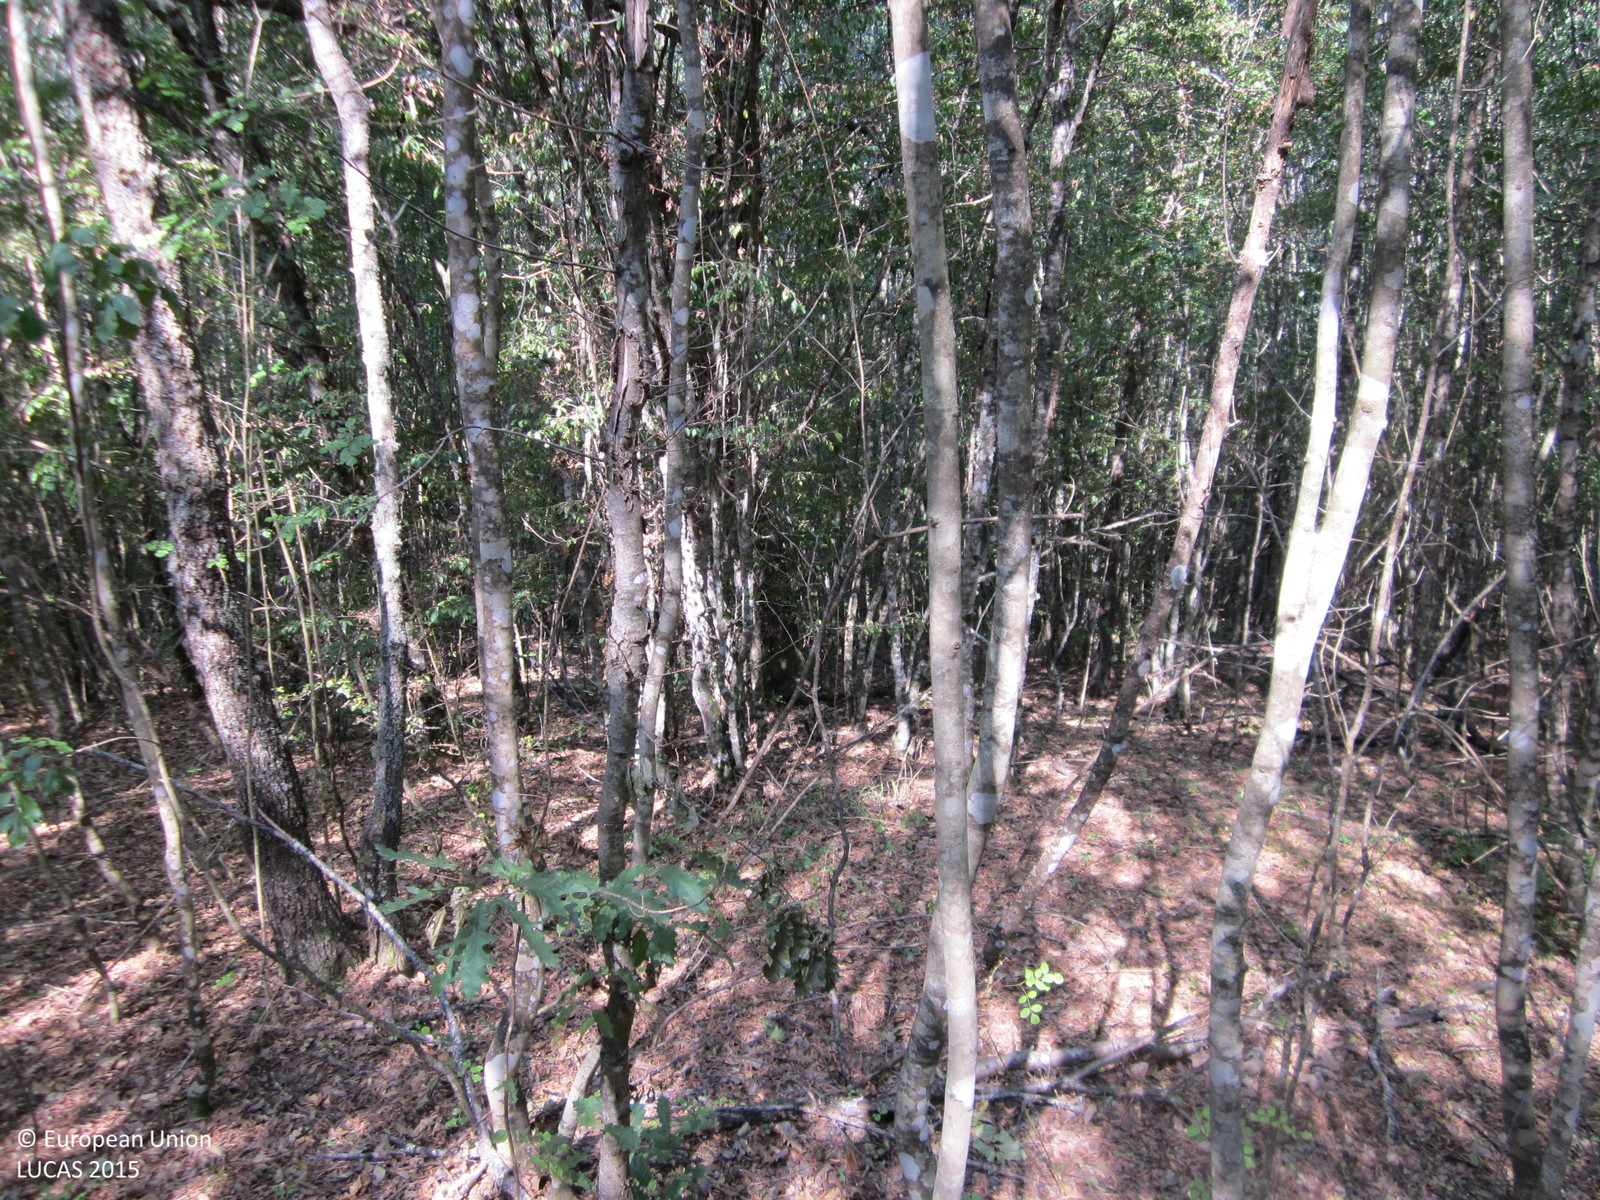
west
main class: Woodland
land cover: Broadleaved woodland
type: thermophilous deciduous forest
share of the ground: > 75 %
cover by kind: broadleaved forest trees 95 %, unconsolidated bare surface 5 %
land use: Forestry
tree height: > 5 m
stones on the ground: < 10 %
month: August
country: BG
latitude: 42.0358
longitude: 27.6177
